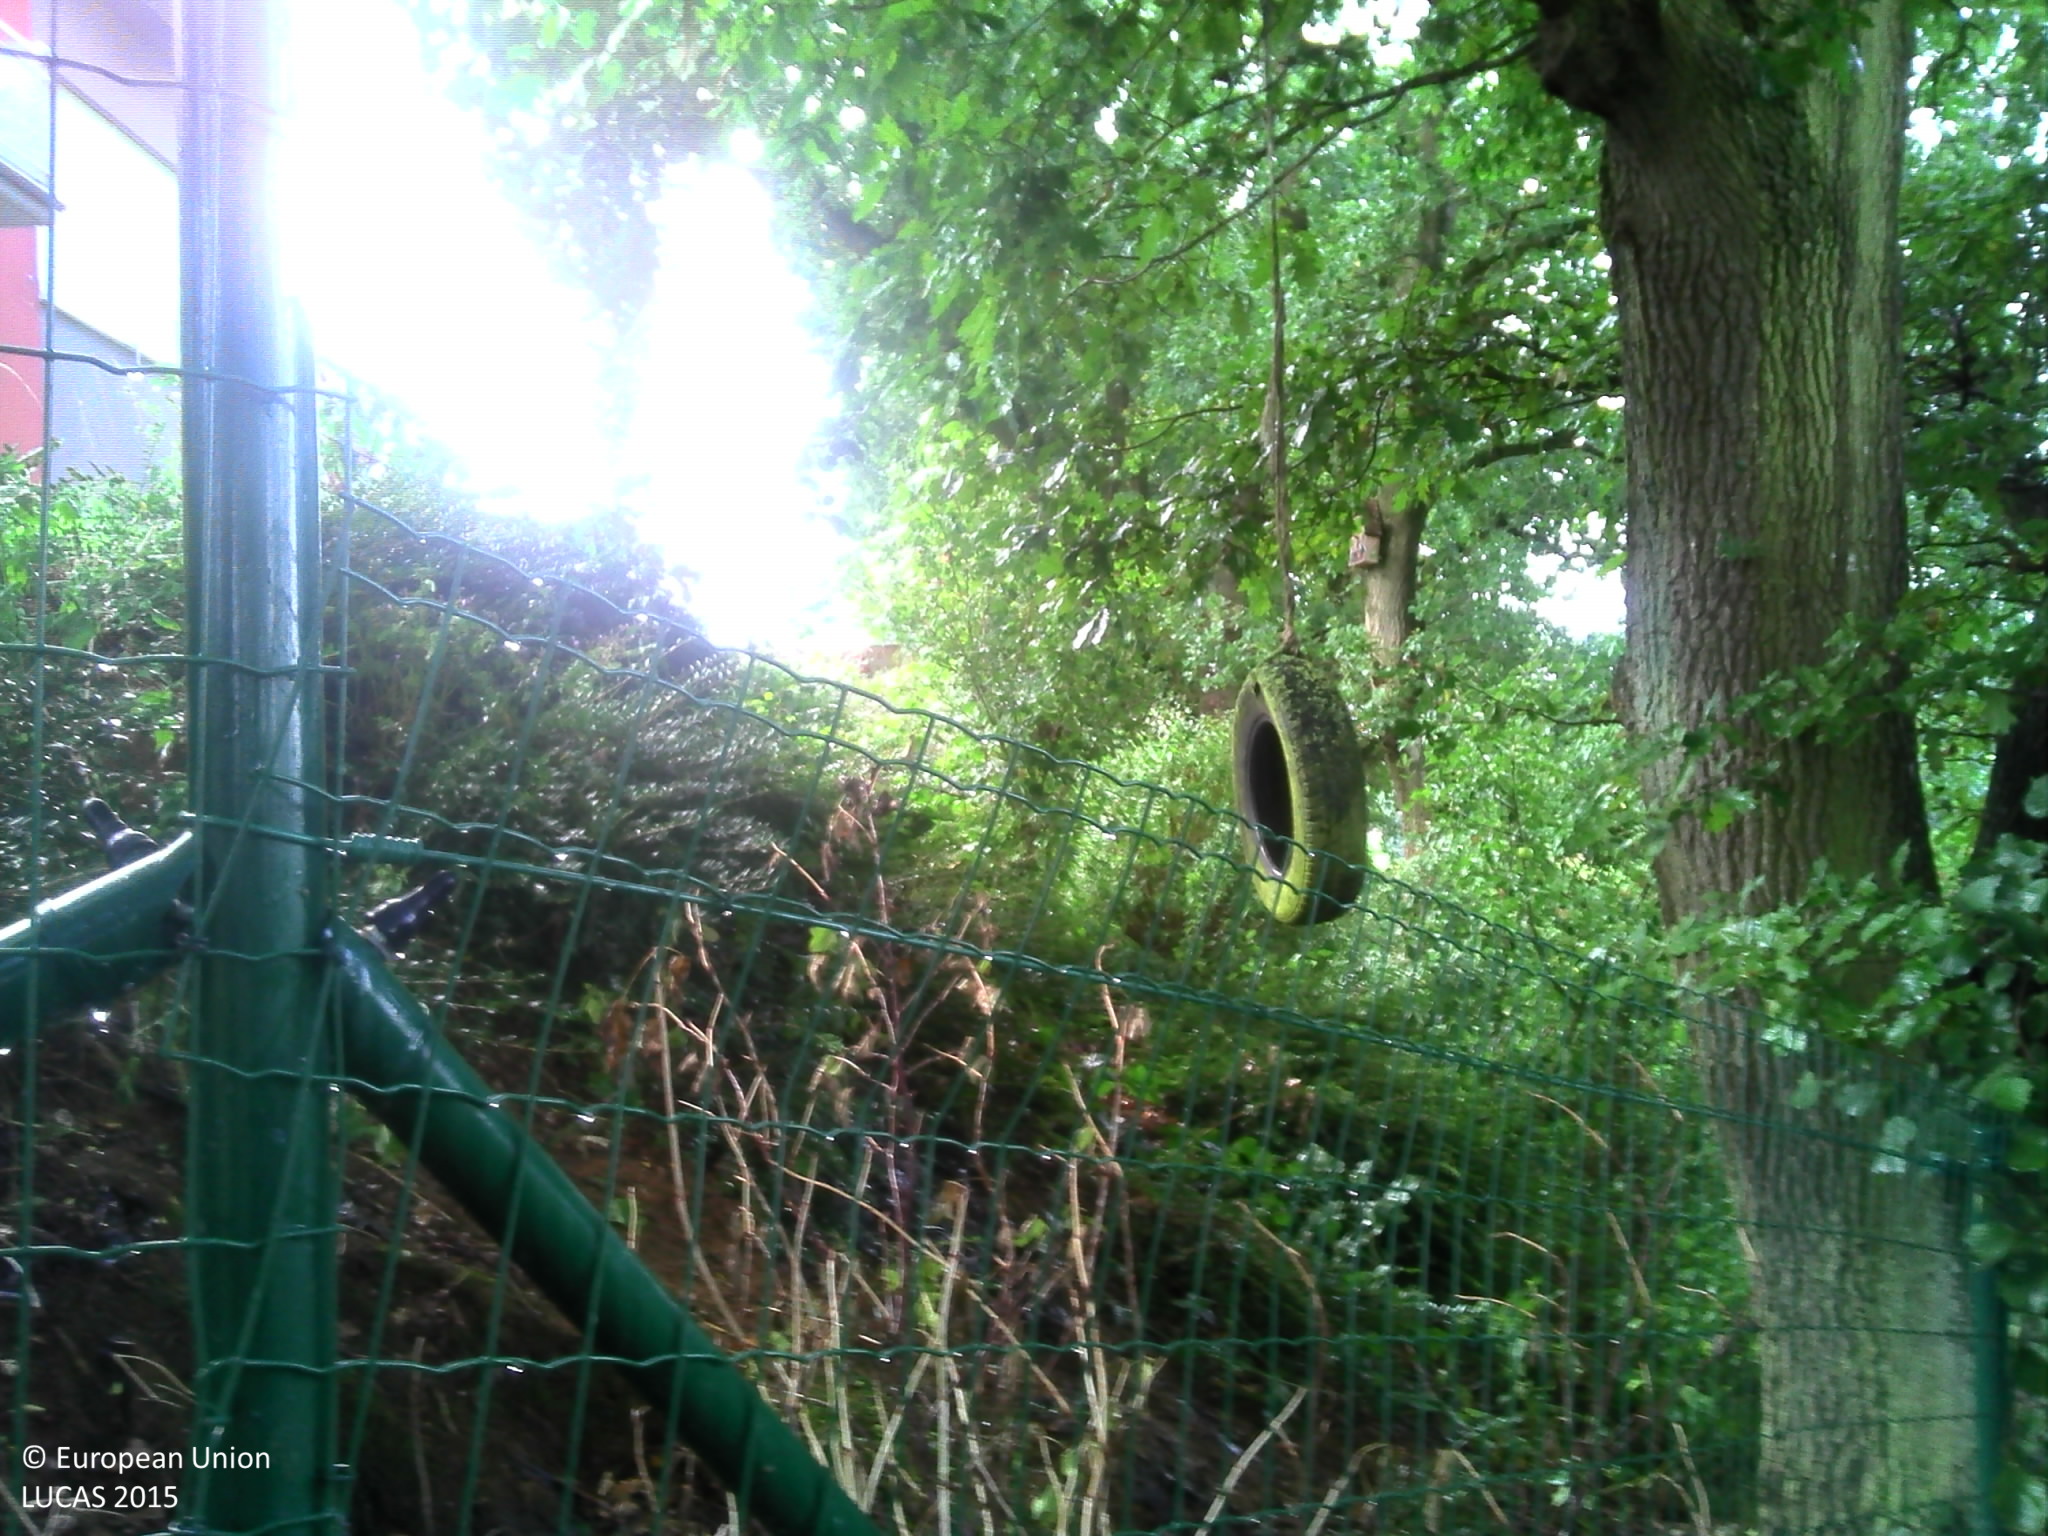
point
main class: Woodland
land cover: Broadleaved woodland
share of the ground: > 75 %
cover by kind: broadleaved forest trees 70 %, herbaceous plants 20 %, unconsolidated bare surface 10 %
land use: Residential
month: September
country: LU
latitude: 49.7725
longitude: 6.0141
